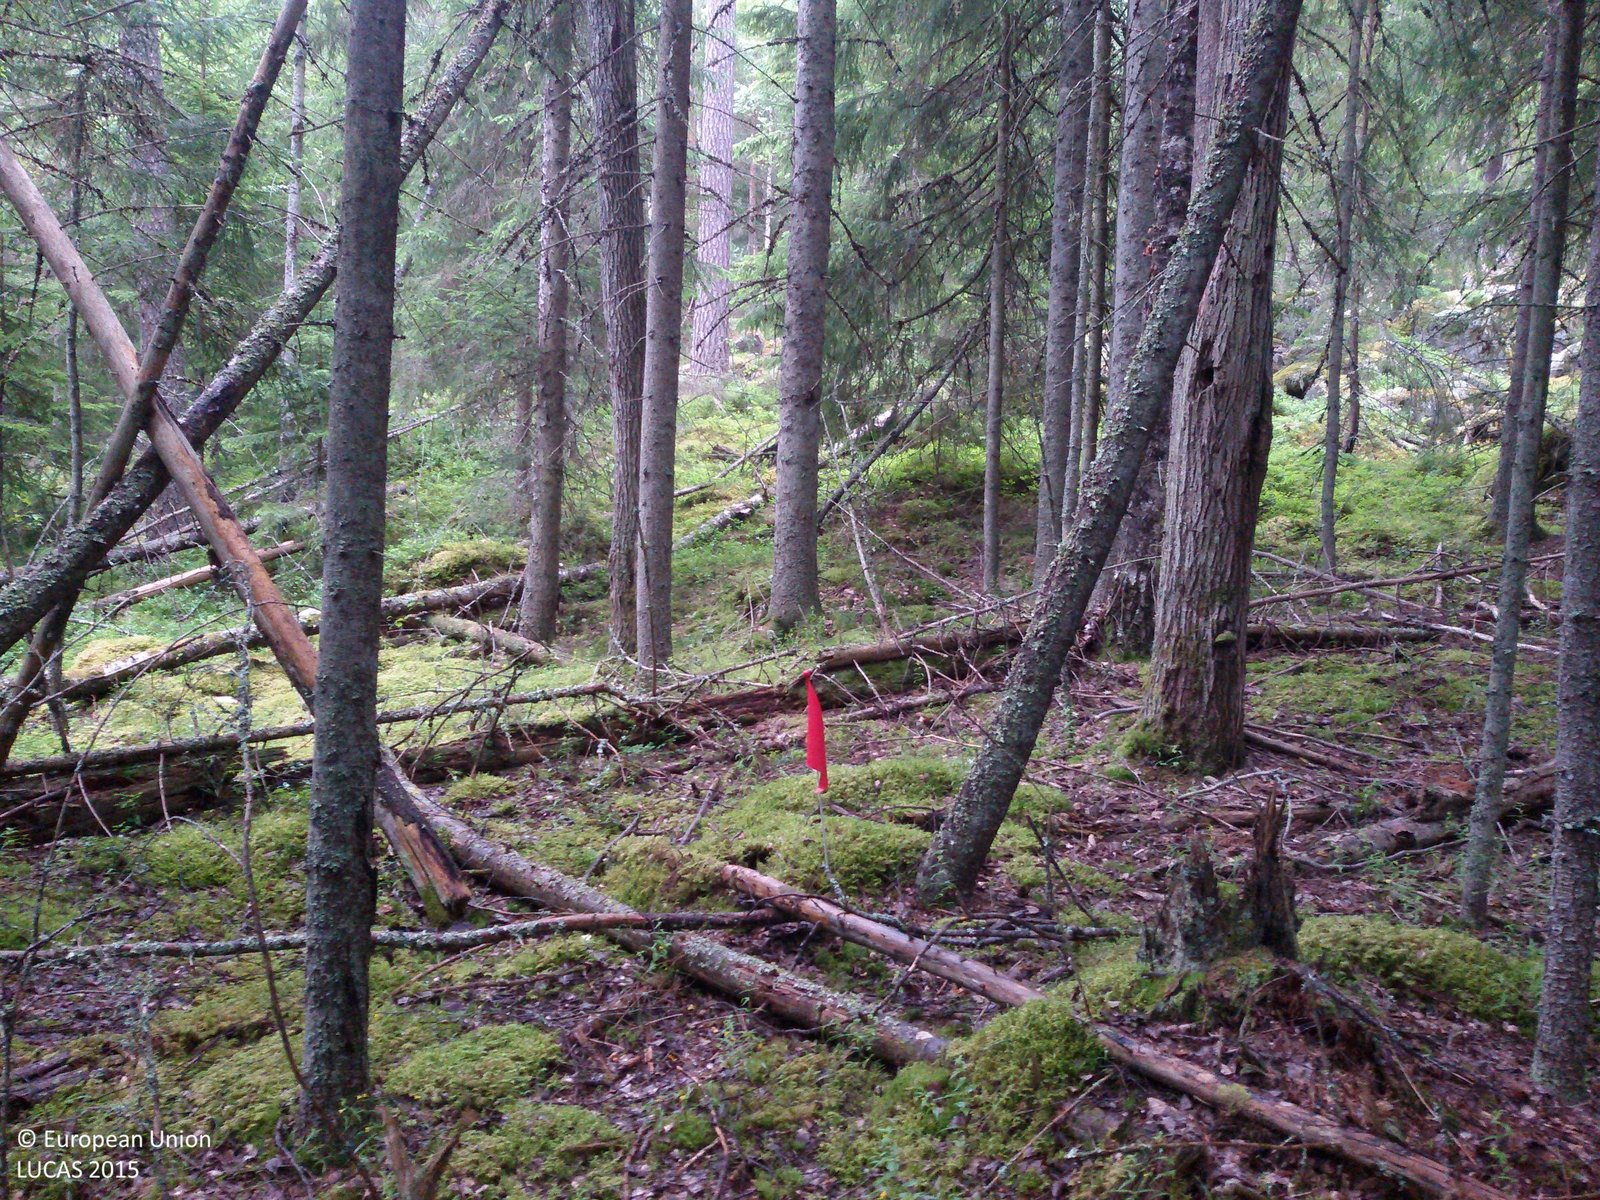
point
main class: Woodland
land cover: Spruce dominated coniferous woodland
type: boreal forest
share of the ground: > 75 %
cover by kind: coniferous forest trees 80 %, herbaceous plants 20 %
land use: Forestry
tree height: > 5 m
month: July
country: SE
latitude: 60.5996
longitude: 15.8860
